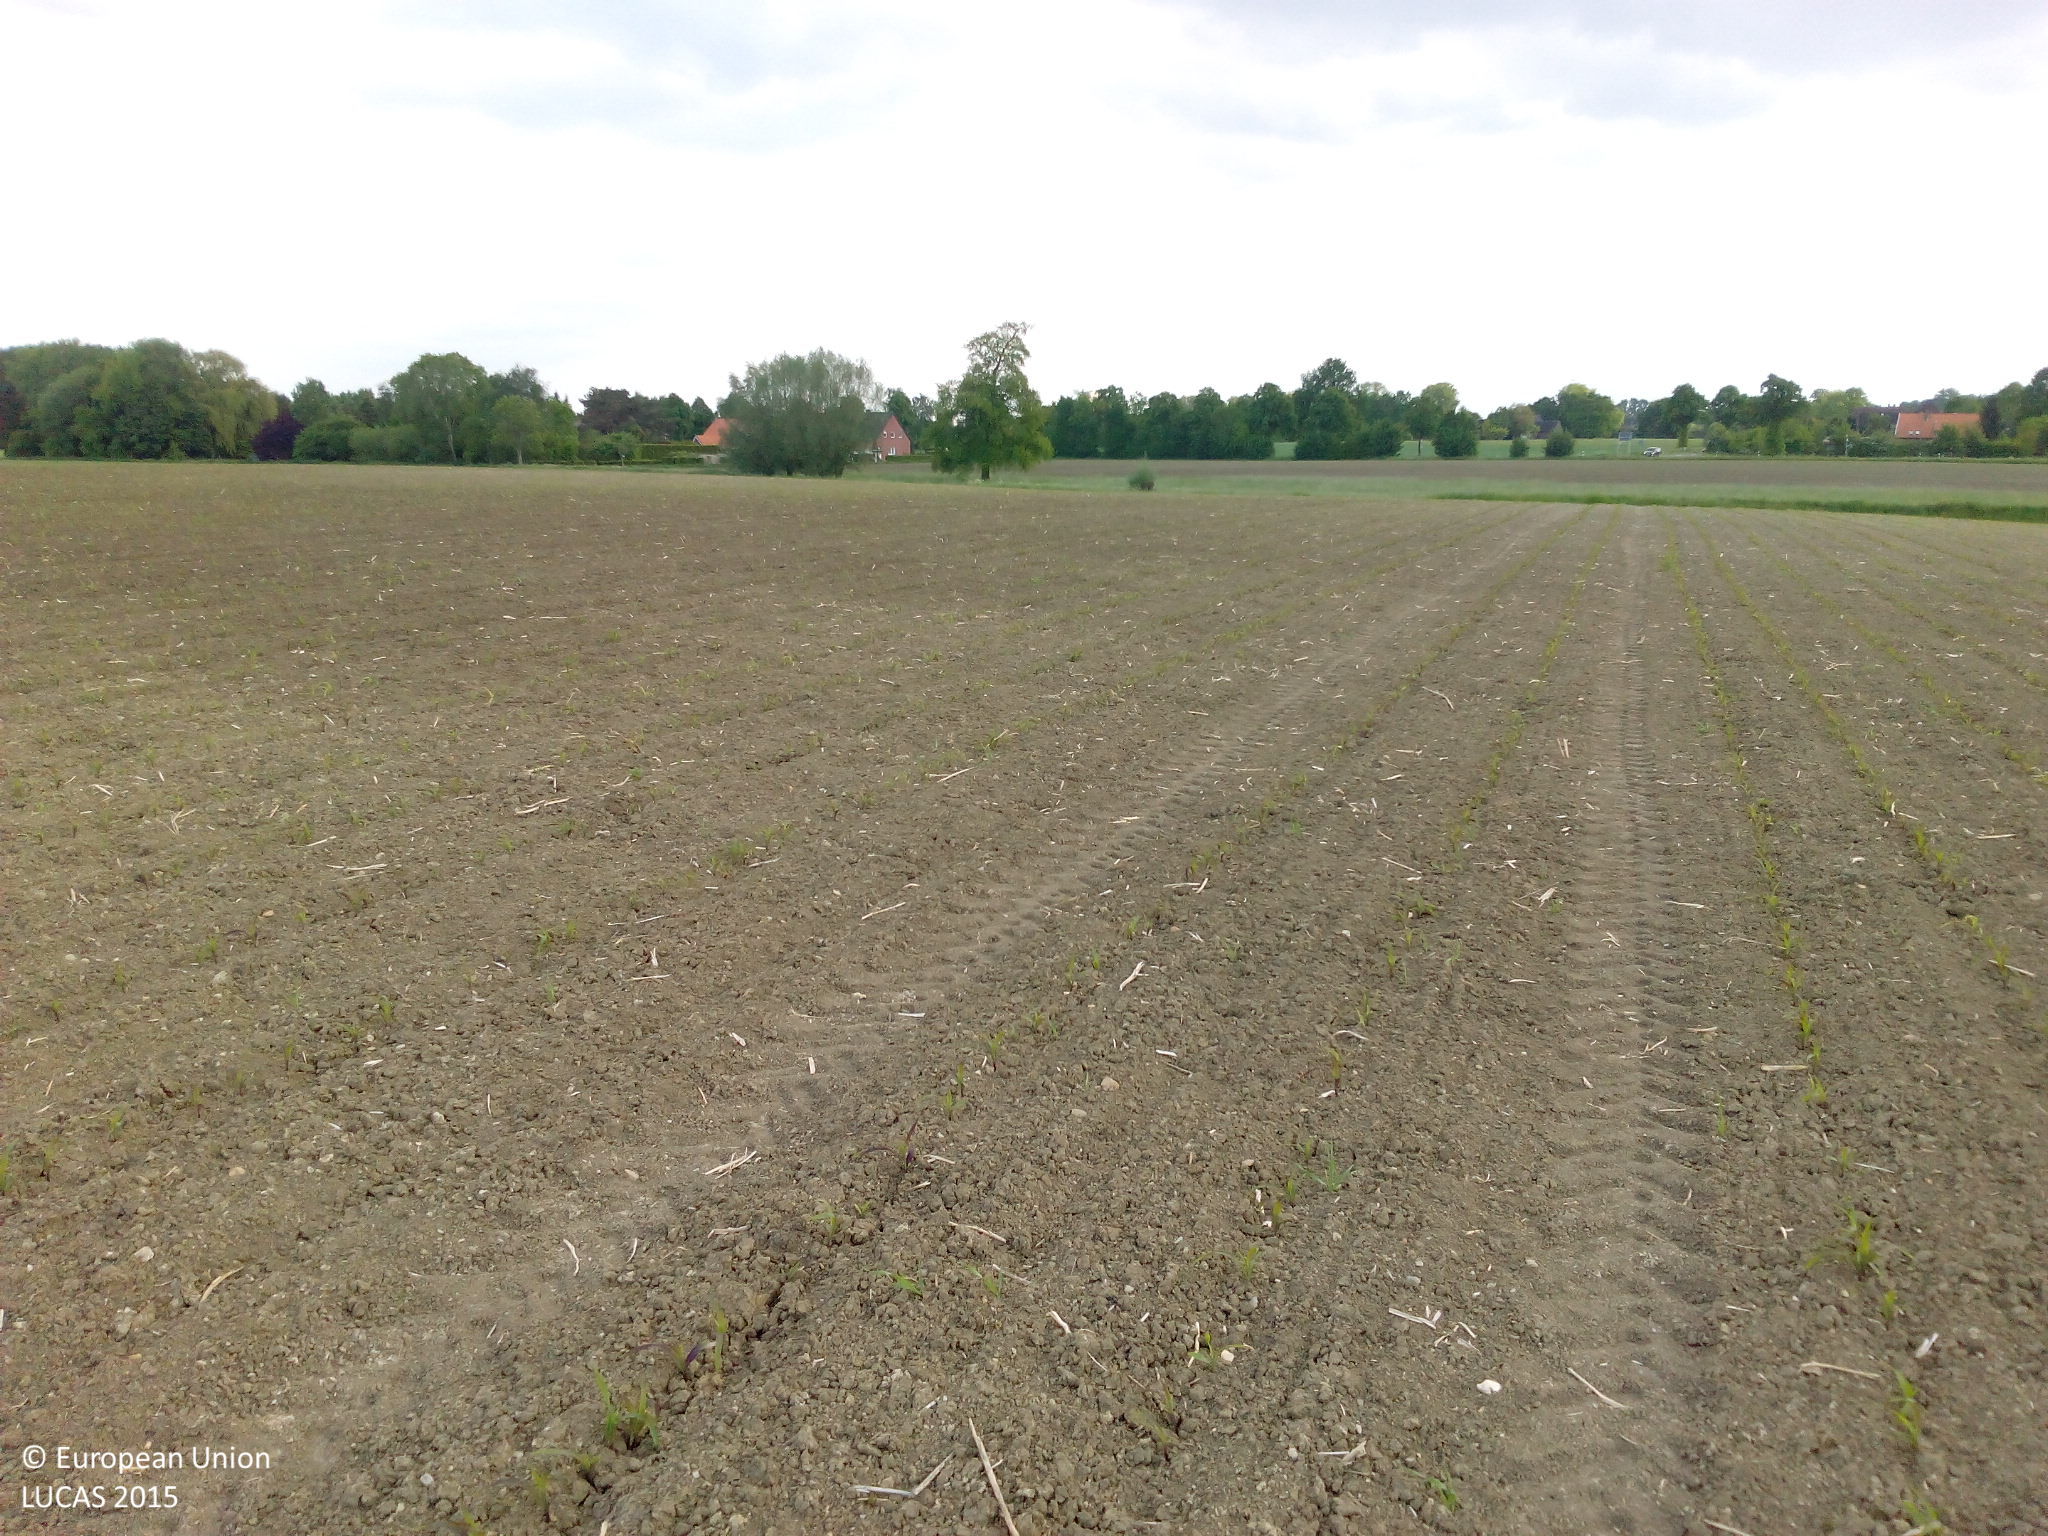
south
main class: Cropland
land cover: Maize
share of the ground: < 10 %
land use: Agriculture (excluding fallow land and kitchen gardens)
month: May
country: DE
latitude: 51.8025
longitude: 7.9556
